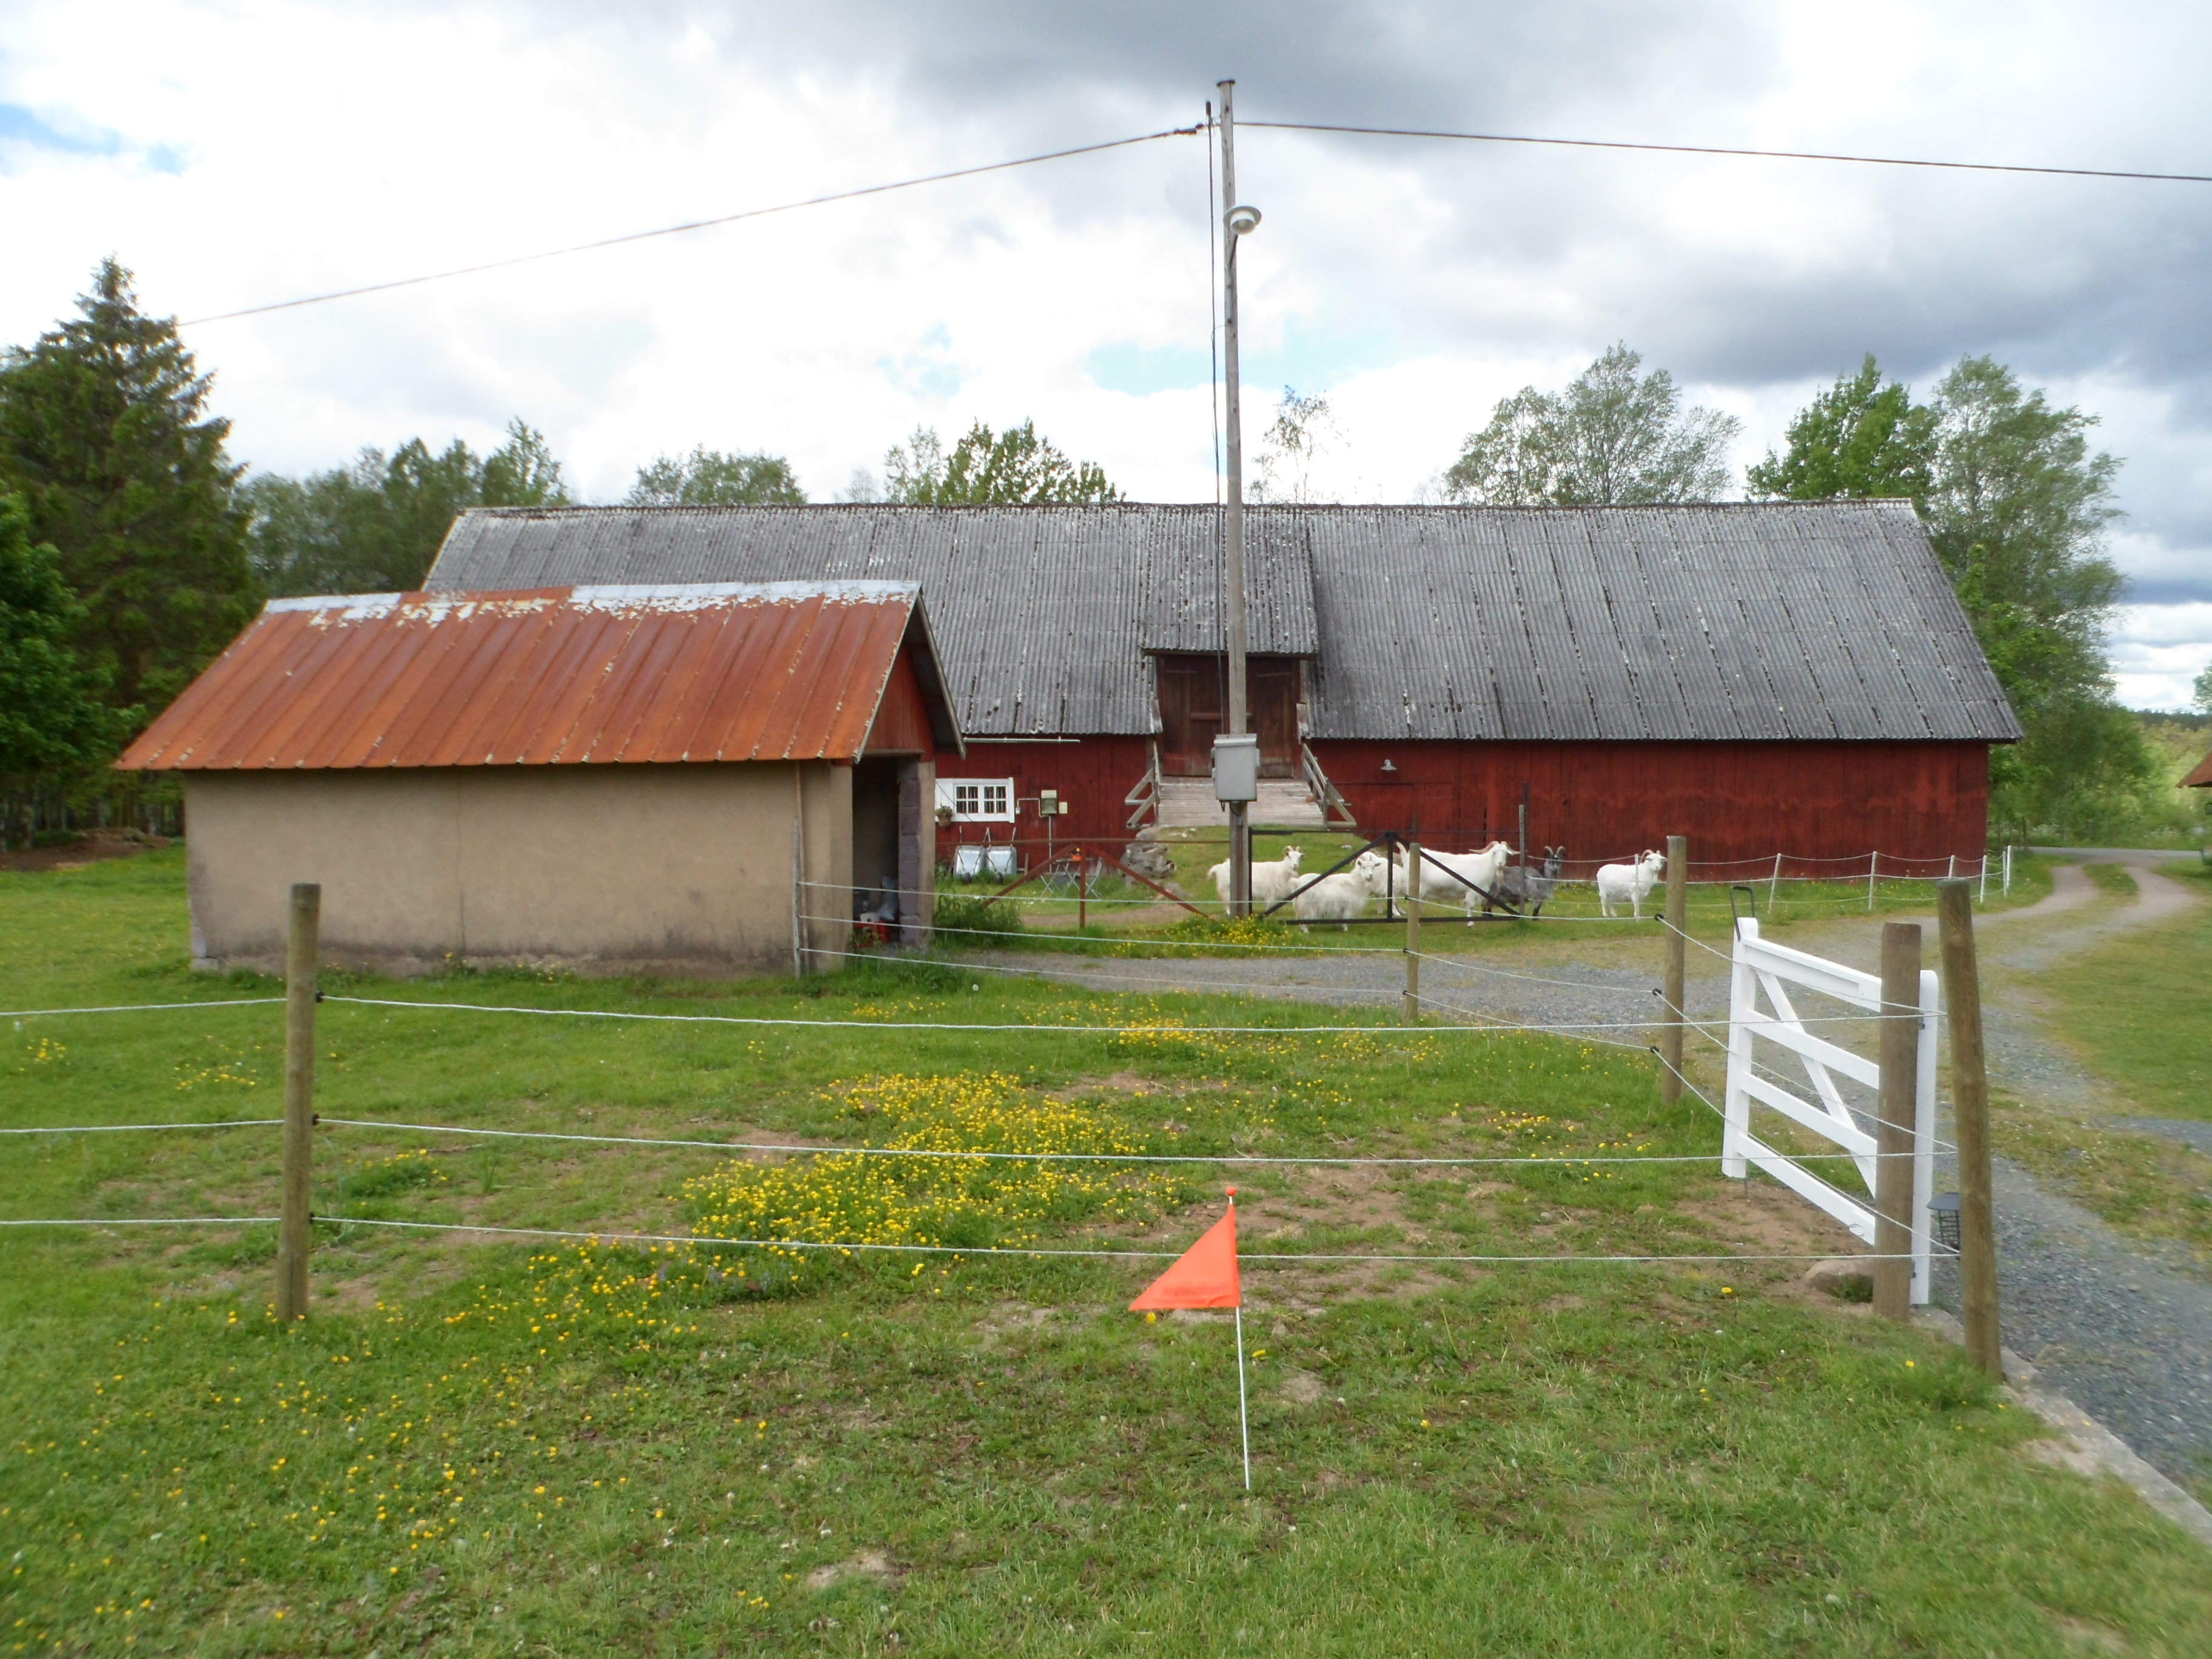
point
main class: Grassland
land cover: Grassland without tree/shrub cover
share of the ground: > 75 %
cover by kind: herbaceous plants 100 %
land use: Residential
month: June
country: SE
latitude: 57.4163
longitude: 14.1746
